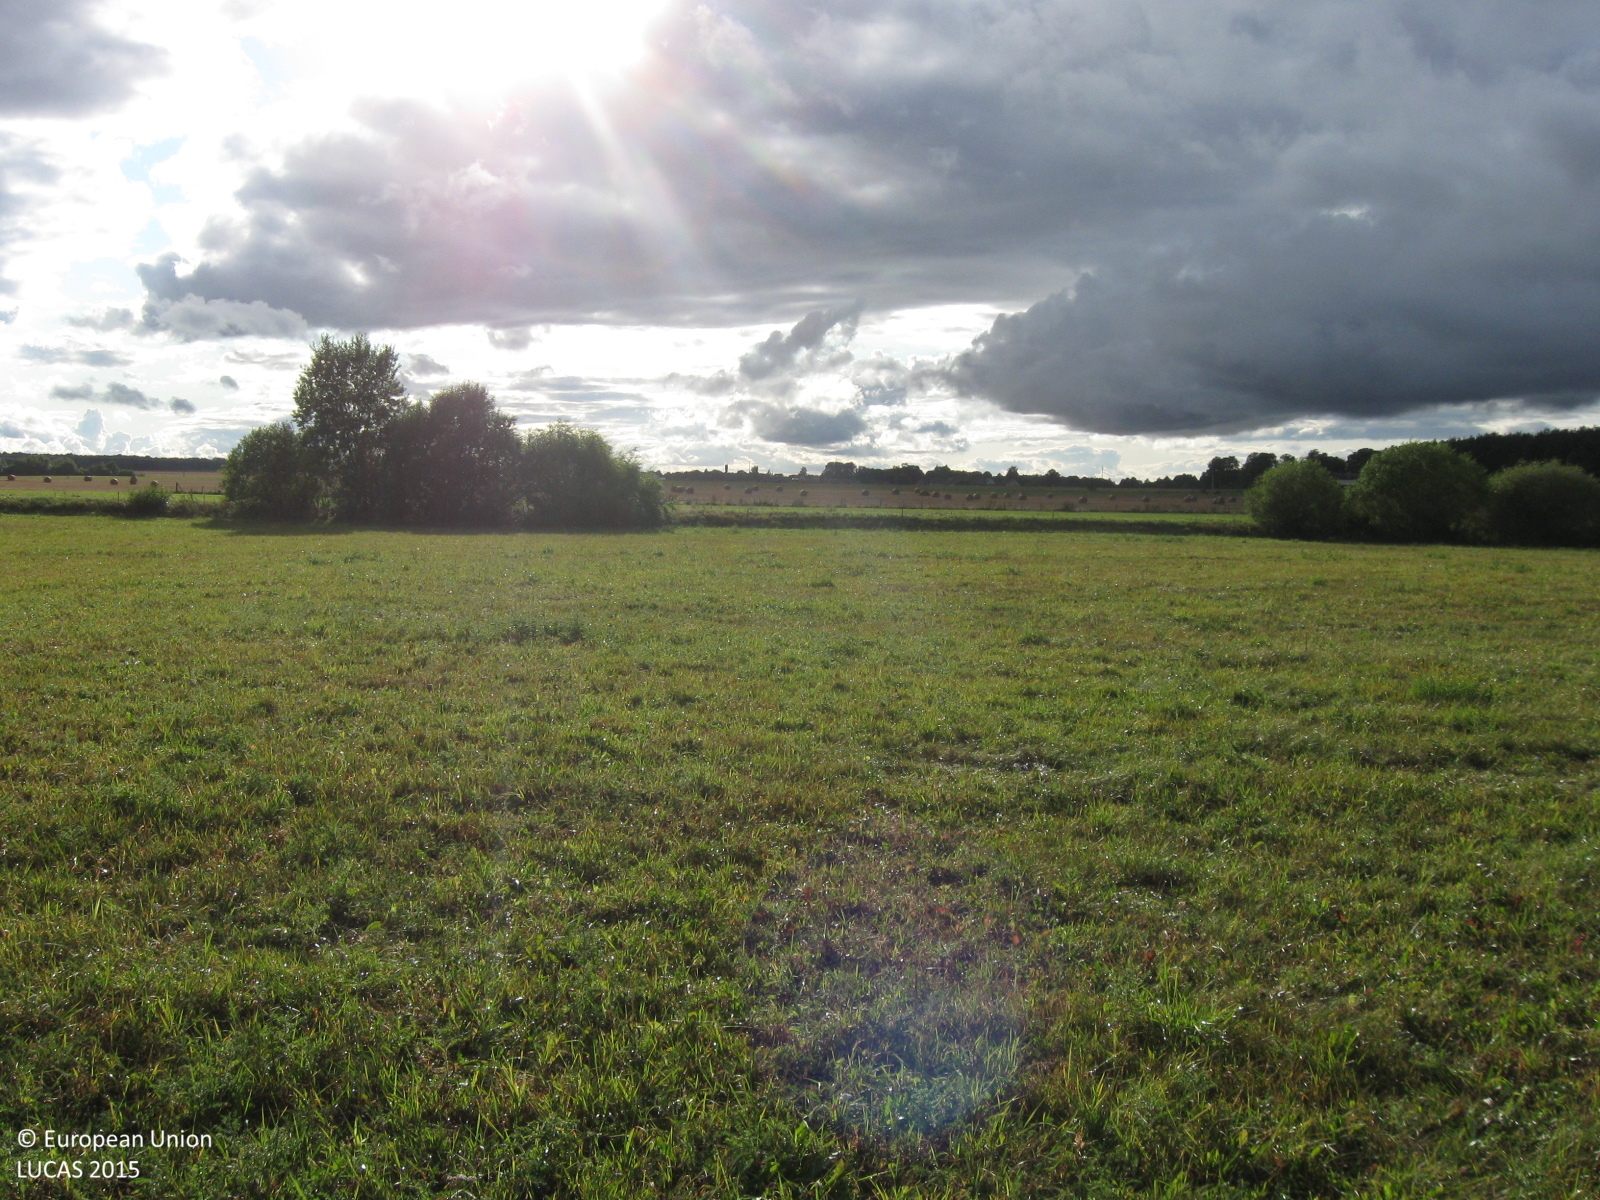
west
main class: Grassland
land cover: Grassland without tree/shrub cover
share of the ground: > 75 %
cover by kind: herbaceous plants 100 %
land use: Agriculture (excluding fallow land and kitchen gardens)
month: August
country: LT
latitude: 55.2599
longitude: 23.2451
